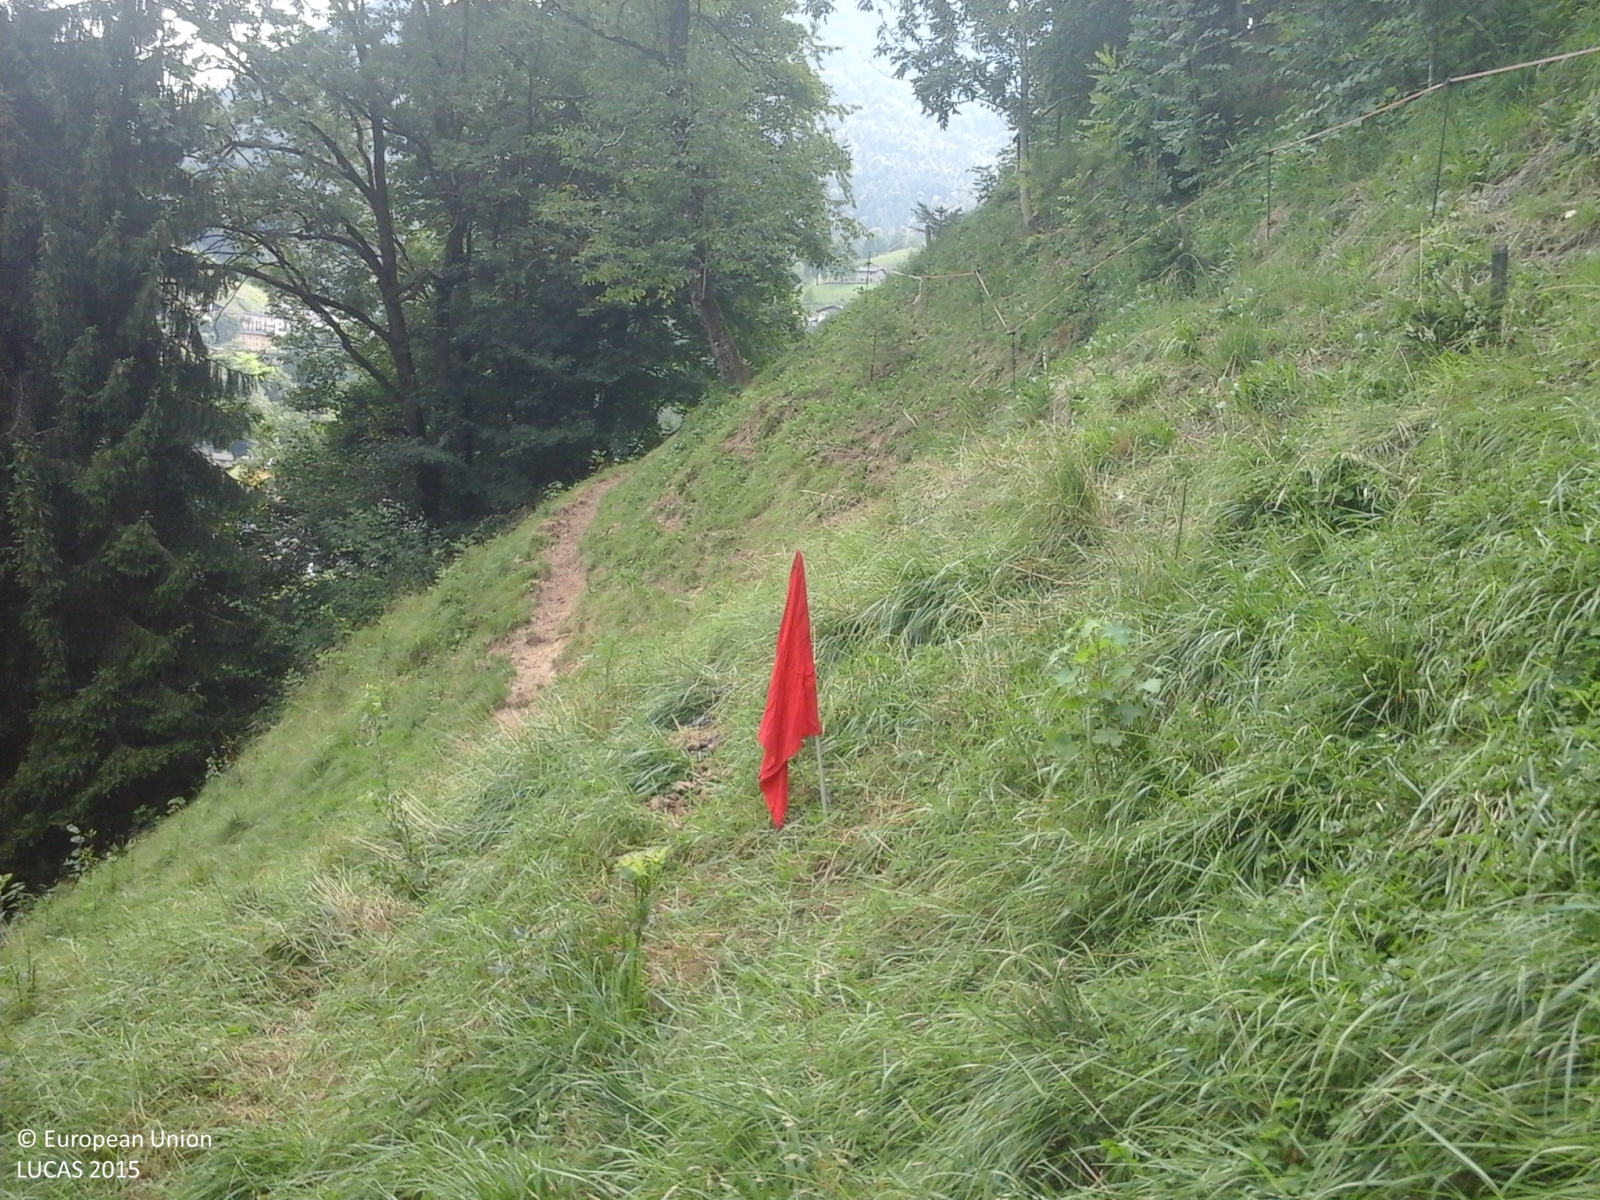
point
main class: Grassland
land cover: Grassland without tree/shrub cover
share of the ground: > 75 %
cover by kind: herbaceous plants 100 %
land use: Agriculture (excluding fallow land and kitchen gardens)
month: July
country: IT
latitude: 45.9903
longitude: 9.6262
